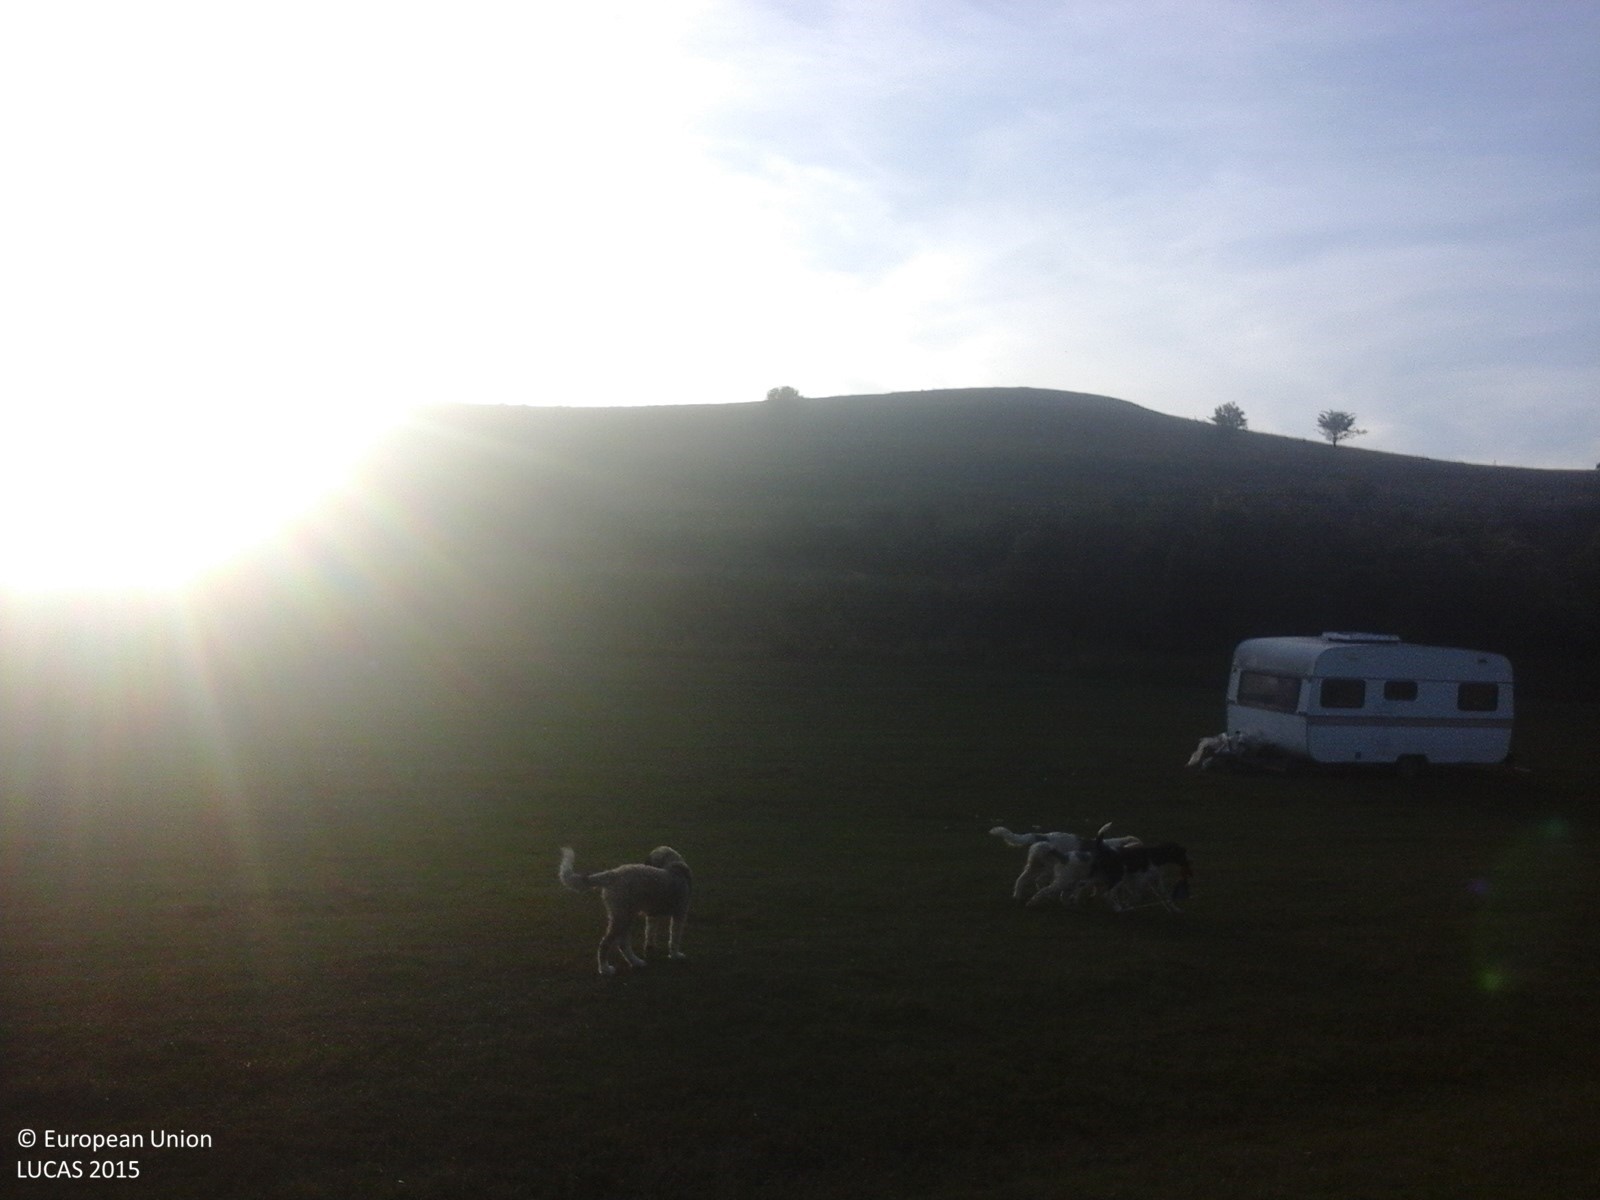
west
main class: Grassland
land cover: Grassland without tree/shrub cover
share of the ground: > 75 %
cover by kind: herbaceous plants 100 %
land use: Agriculture (excluding fallow land and kitchen gardens)
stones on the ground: < 10 %
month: September
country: RO
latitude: 46.7854
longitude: 23.3624
